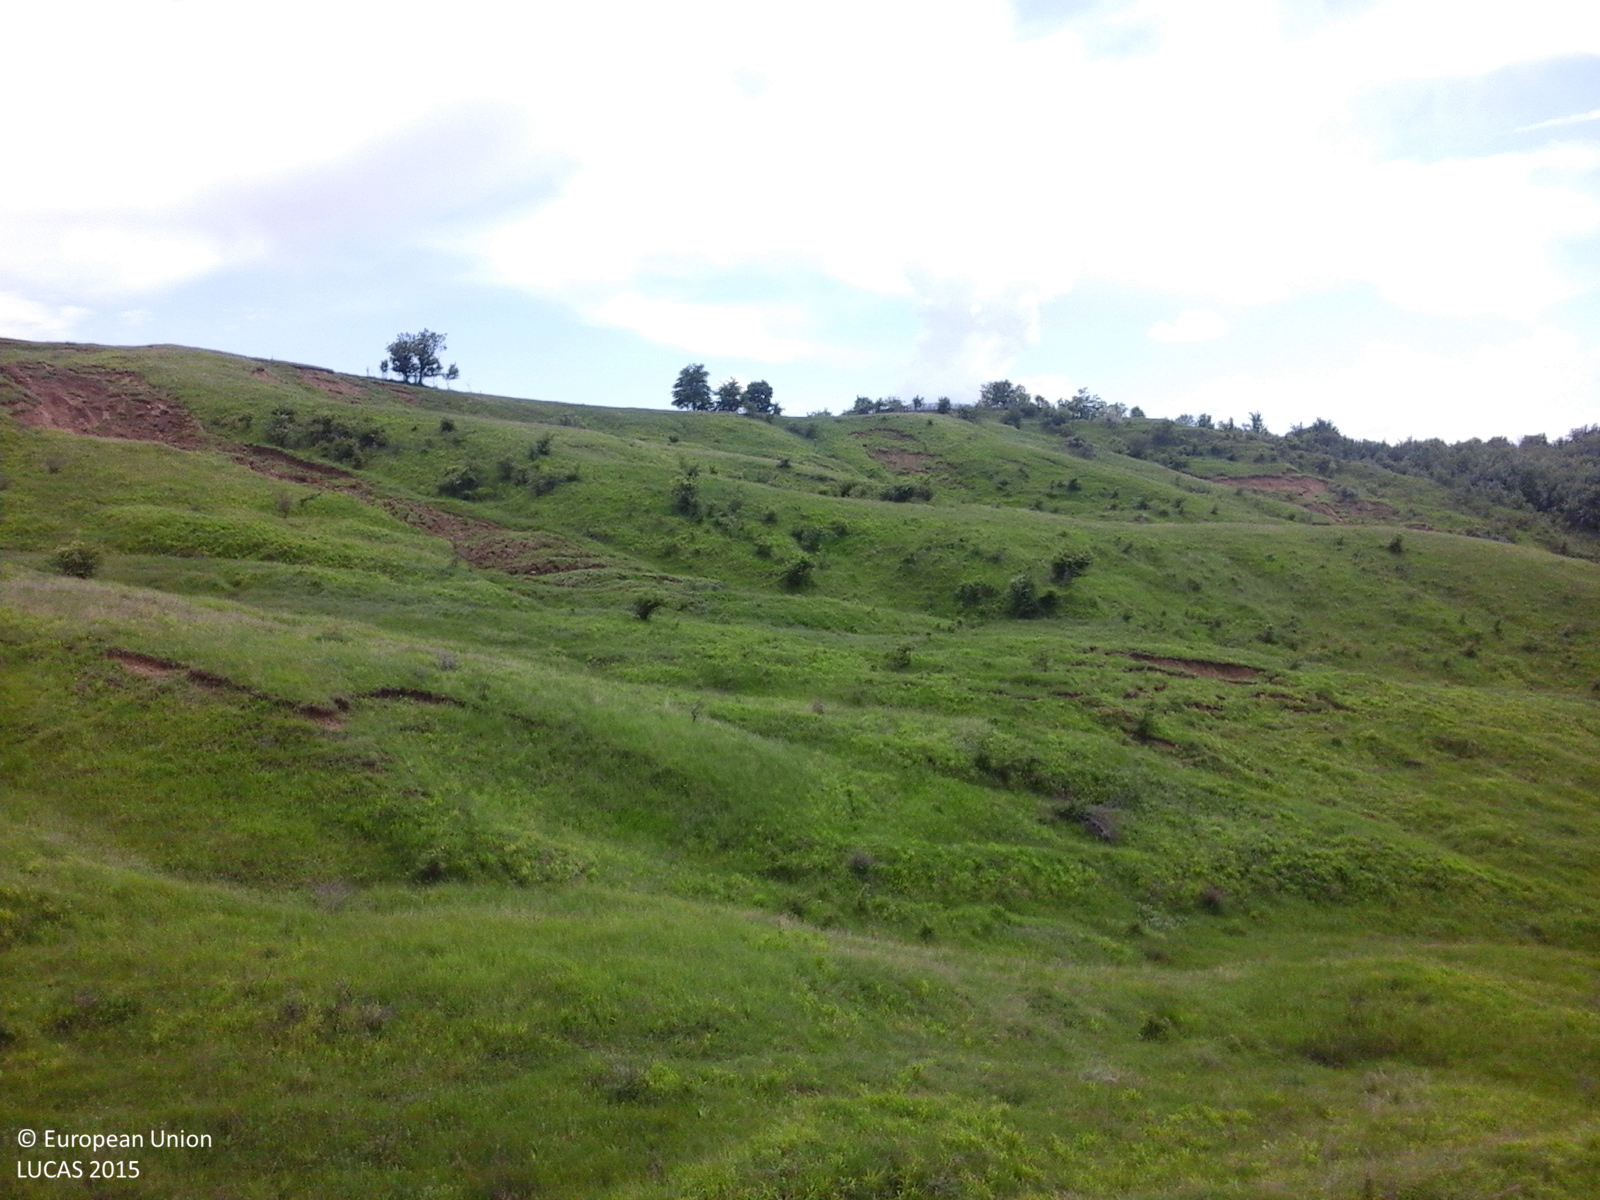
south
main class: Grassland
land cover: Grassland without tree/shrub cover
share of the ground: > 75 %
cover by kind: herbaceous plants 100 %
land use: Agriculture (excluding fallow land and kitchen gardens)
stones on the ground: < 10 %
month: May
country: RO
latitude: 45.1363
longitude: 26.1220
